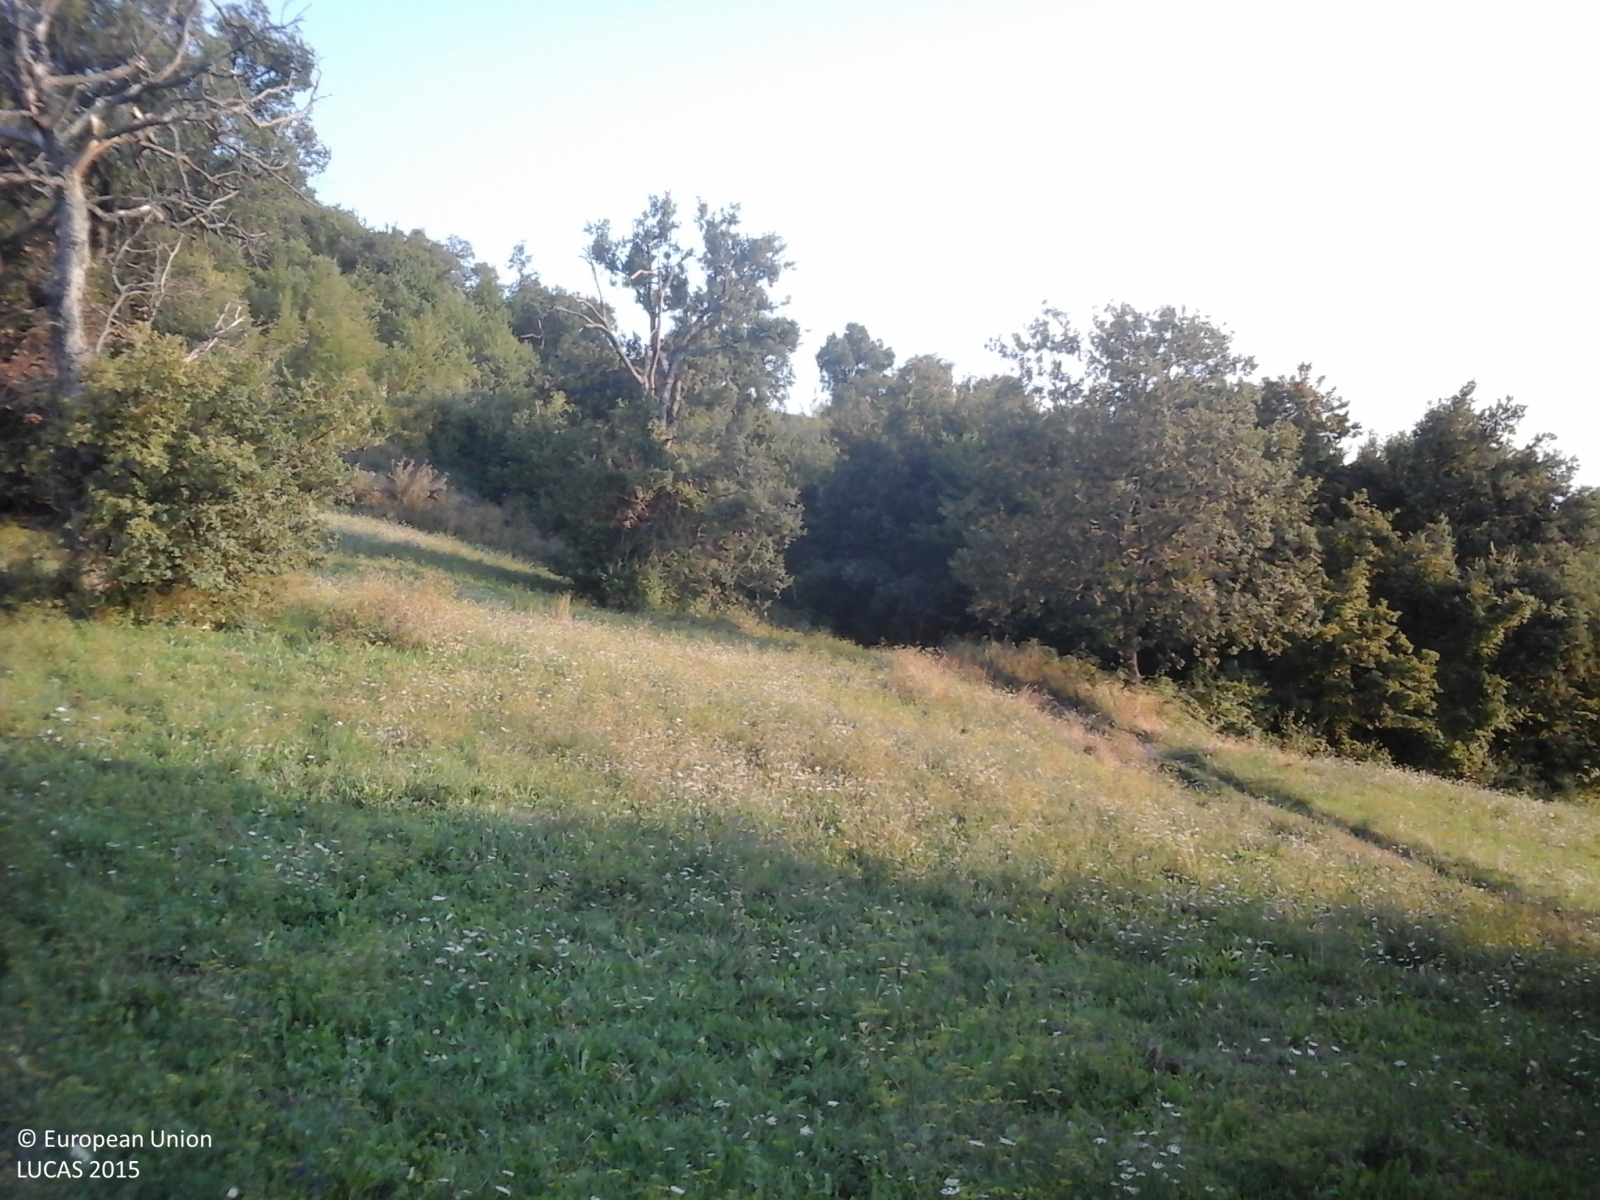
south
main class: Grassland
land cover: Grassland without tree/shrub cover
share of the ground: > 75 %
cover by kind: herbaceous plants 100 %
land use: Semi-natural and natural areas not in use
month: August
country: IT
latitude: 42.9769
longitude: 13.3872
